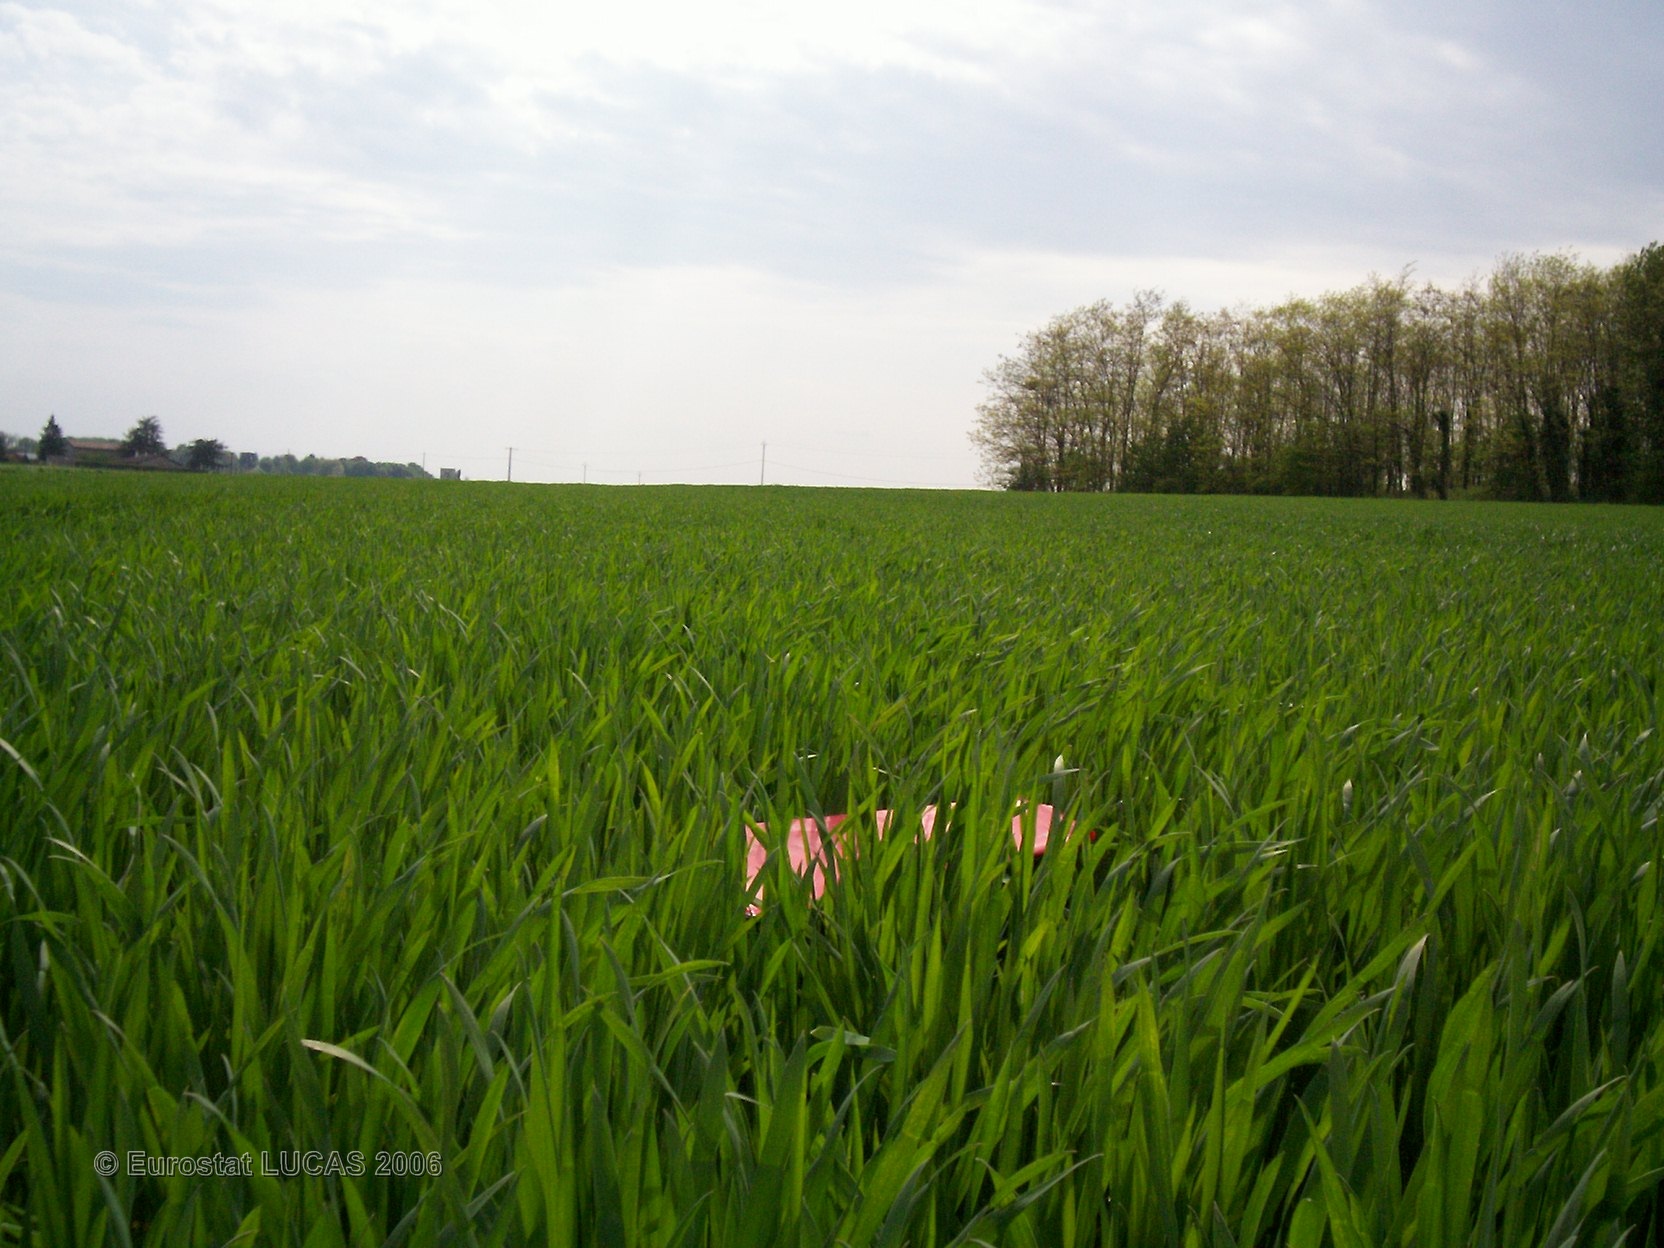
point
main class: Cropland
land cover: Common wheat
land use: Agriculture (excluding fallow land and kitchen gardens)
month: May
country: FR
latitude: 45.9901
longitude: 4.8002
